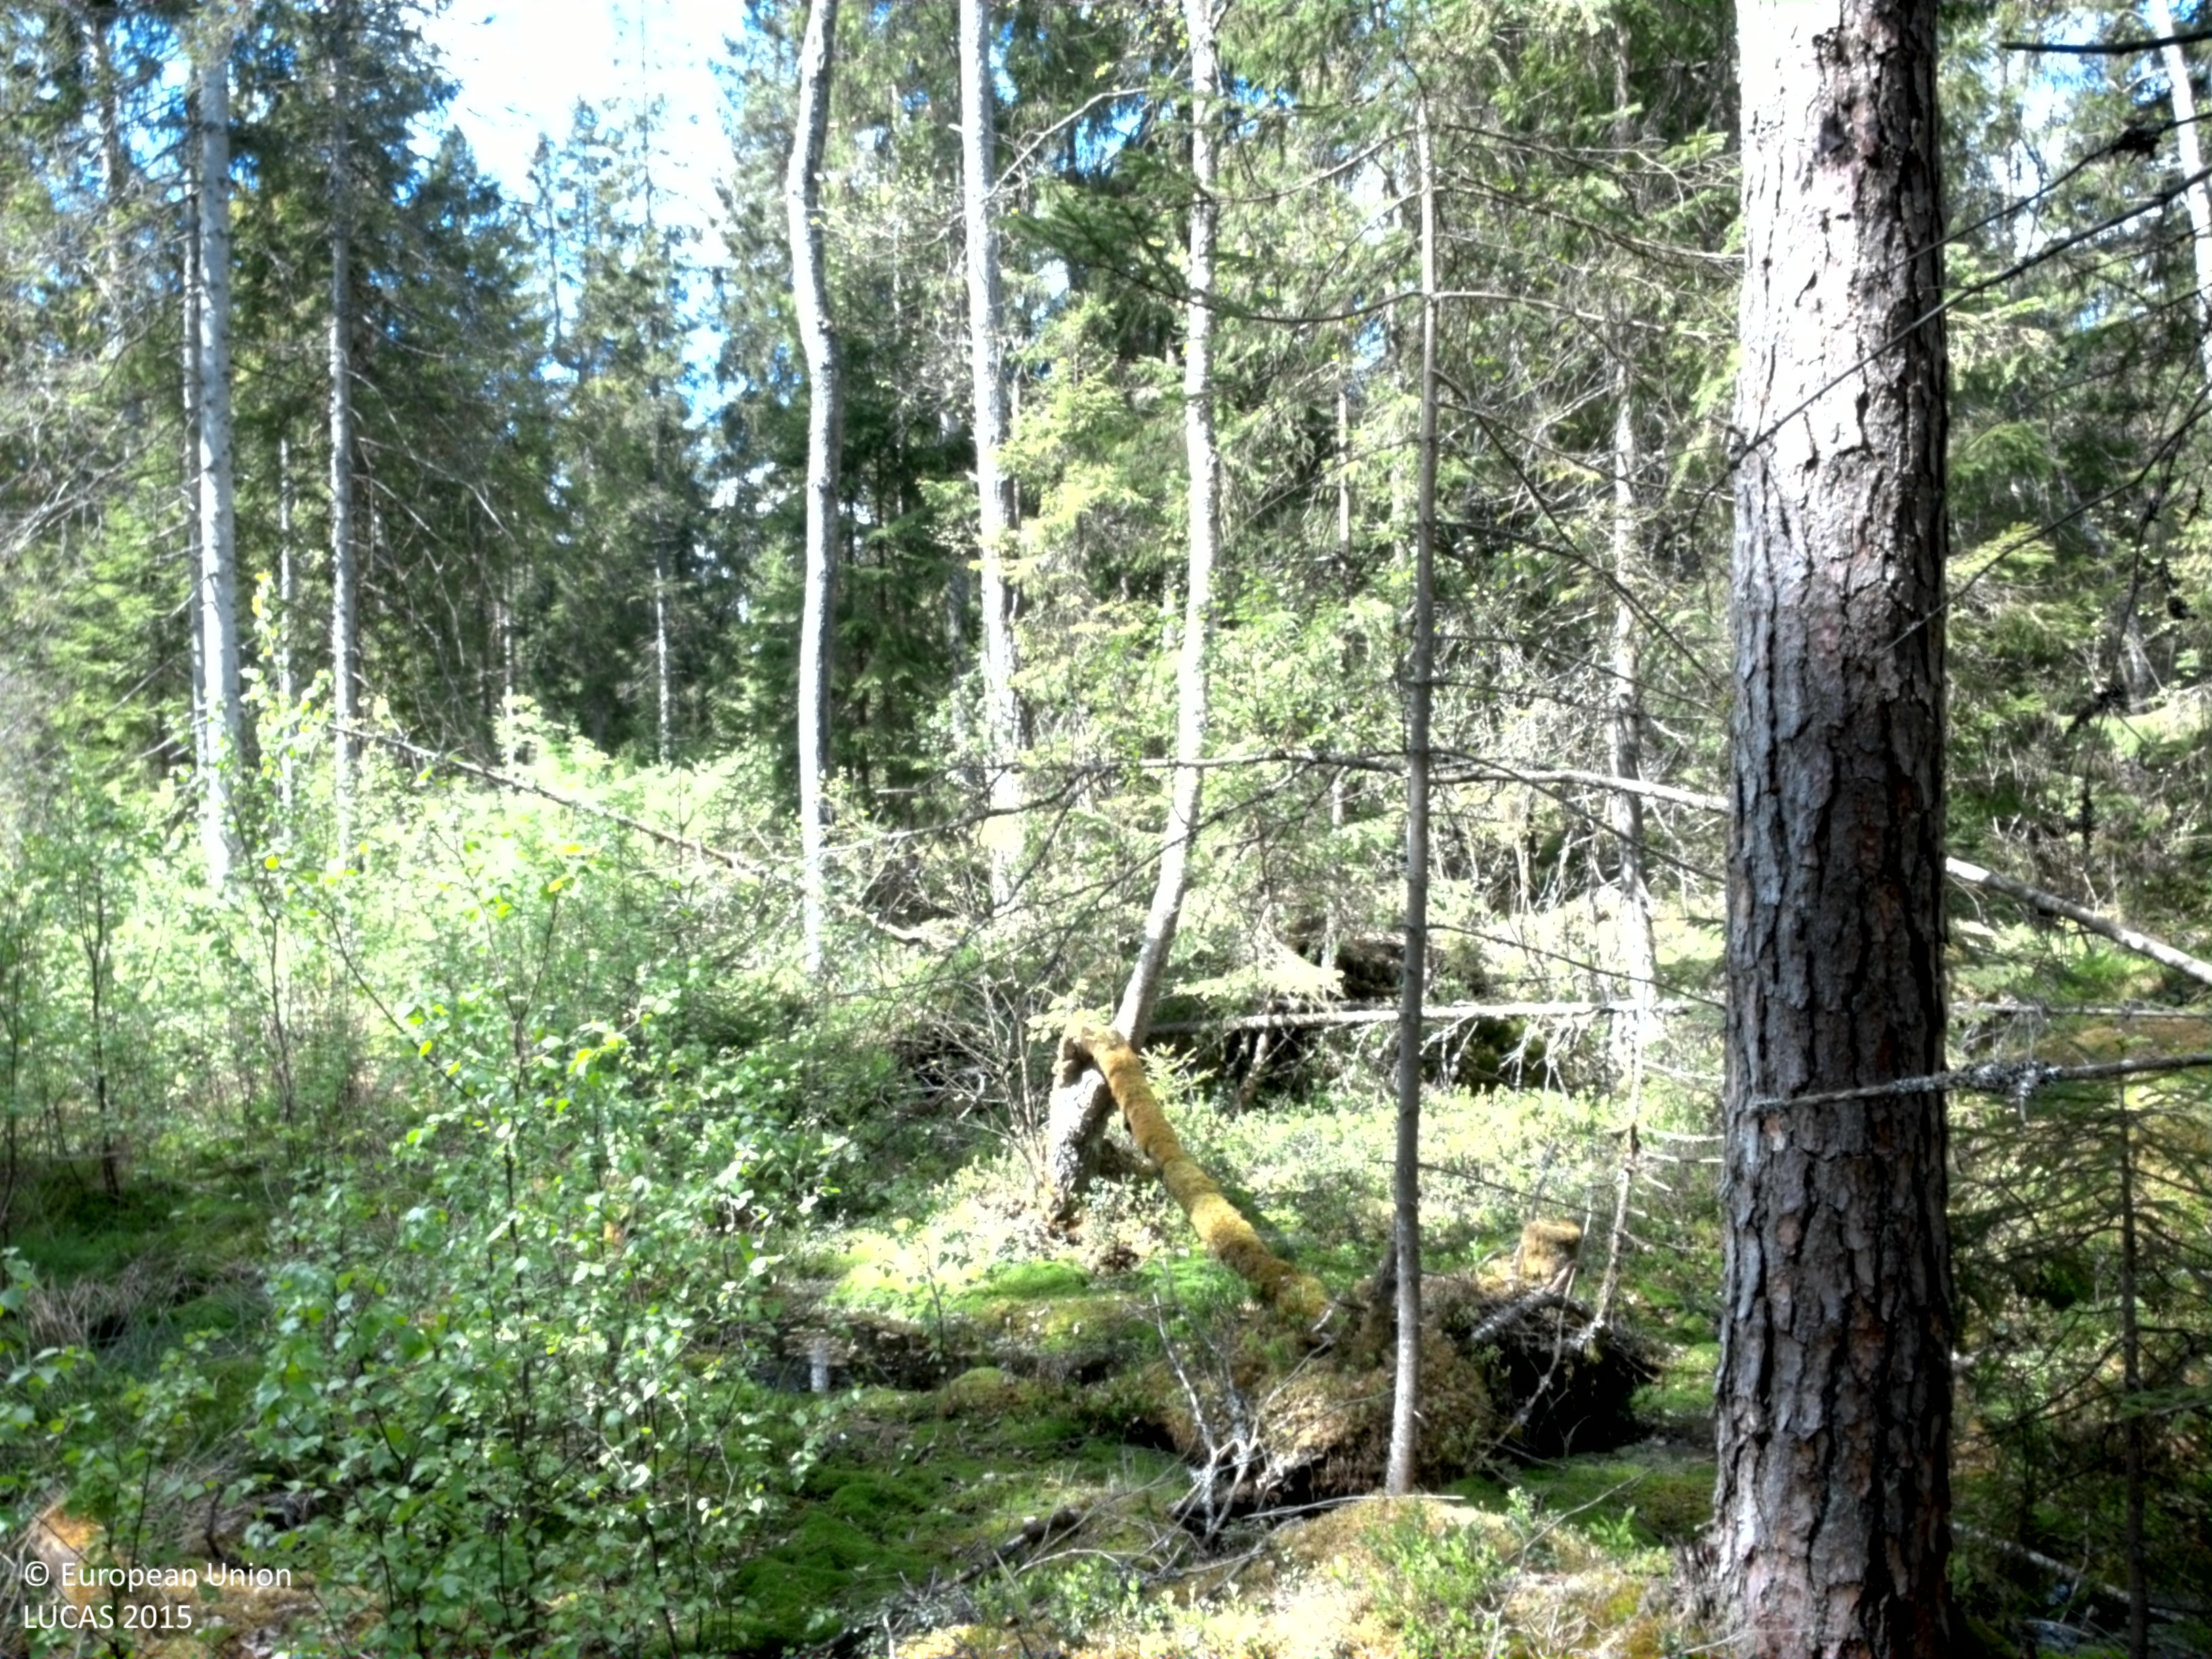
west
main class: Woodland
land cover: Pine dominated coniferous woodland
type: boreal forest
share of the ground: > 75 %
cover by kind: coniferous forest trees 60 %, broadleaved forest trees 20 %, shrubs 10 %, lichens and mosses 10 %
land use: Forestry
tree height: > 5 m
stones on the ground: < 10 %
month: May
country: SE
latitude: 56.5971
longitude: 14.4436
